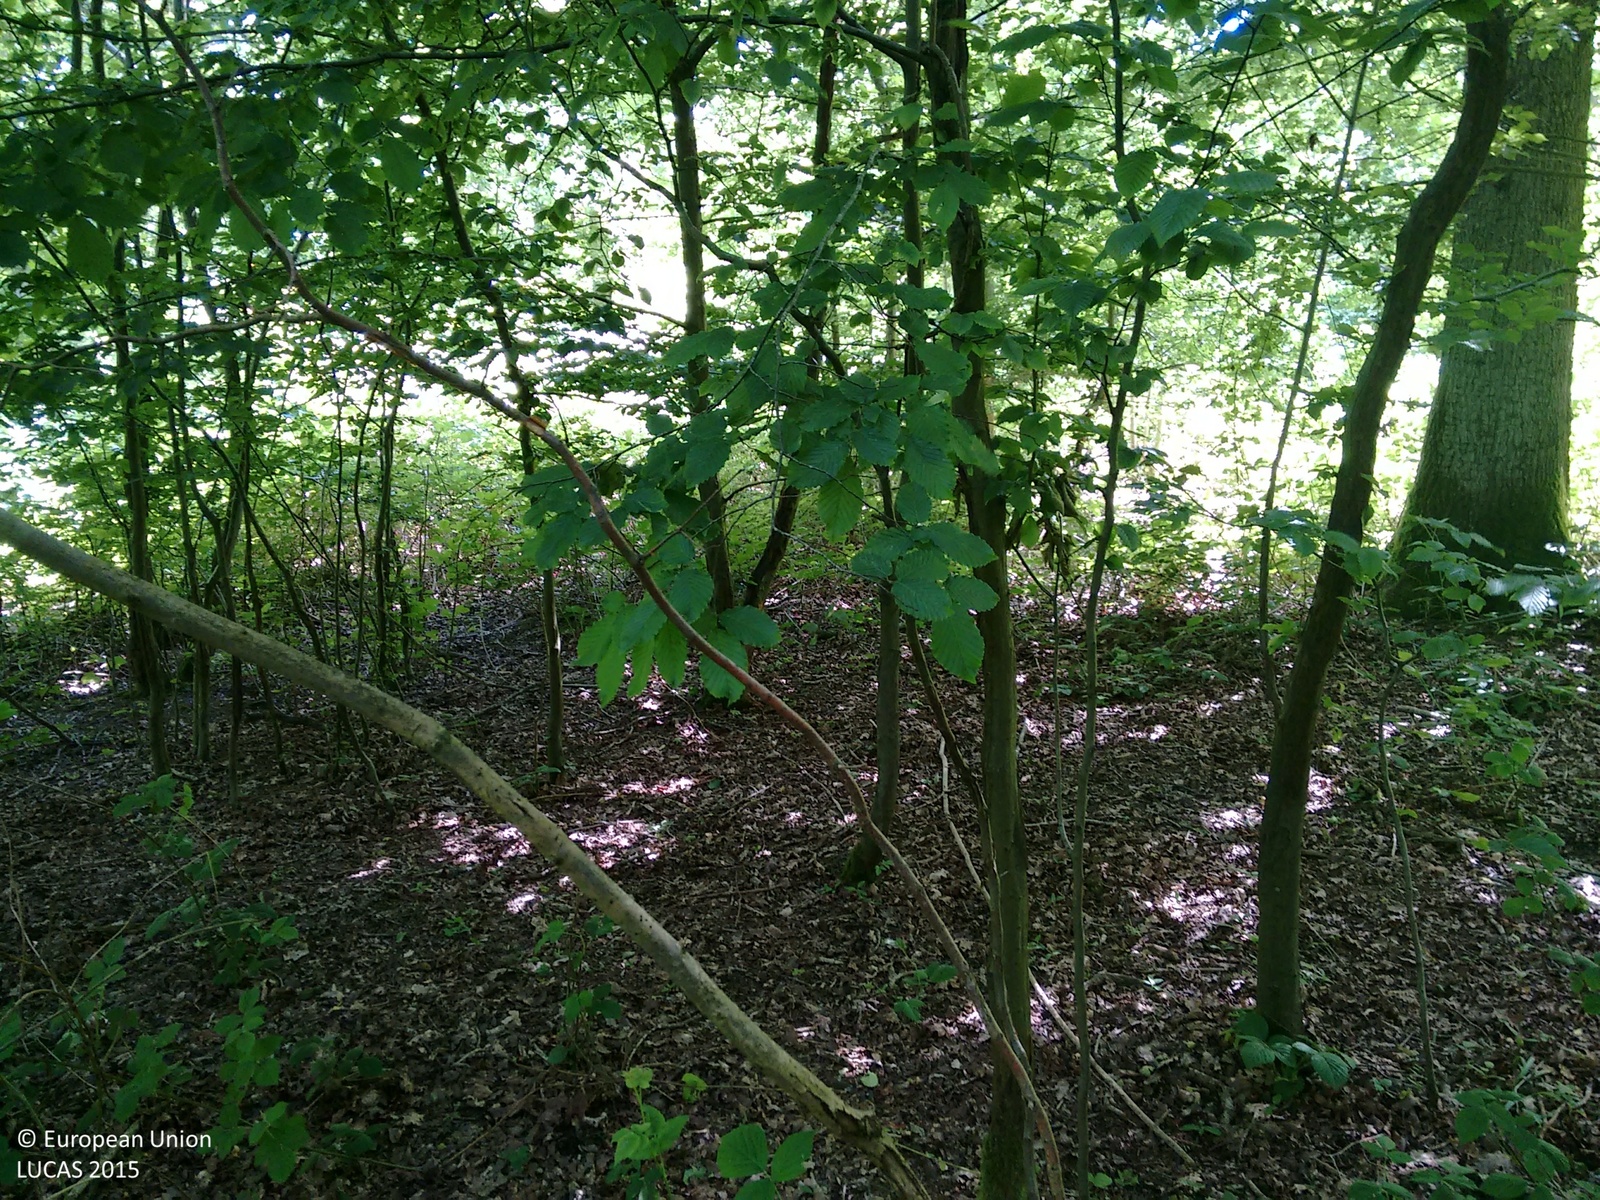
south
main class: Woodland
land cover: Broadleaved woodland
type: mesophytic deciduous forest
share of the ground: > 75 %
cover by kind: broadleaved forest trees 60 %, shrubs 35 %, herbaceous plants 5 %
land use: Forestry
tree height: > 5 m
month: June
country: GB
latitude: 50.9578
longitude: 0.6485
